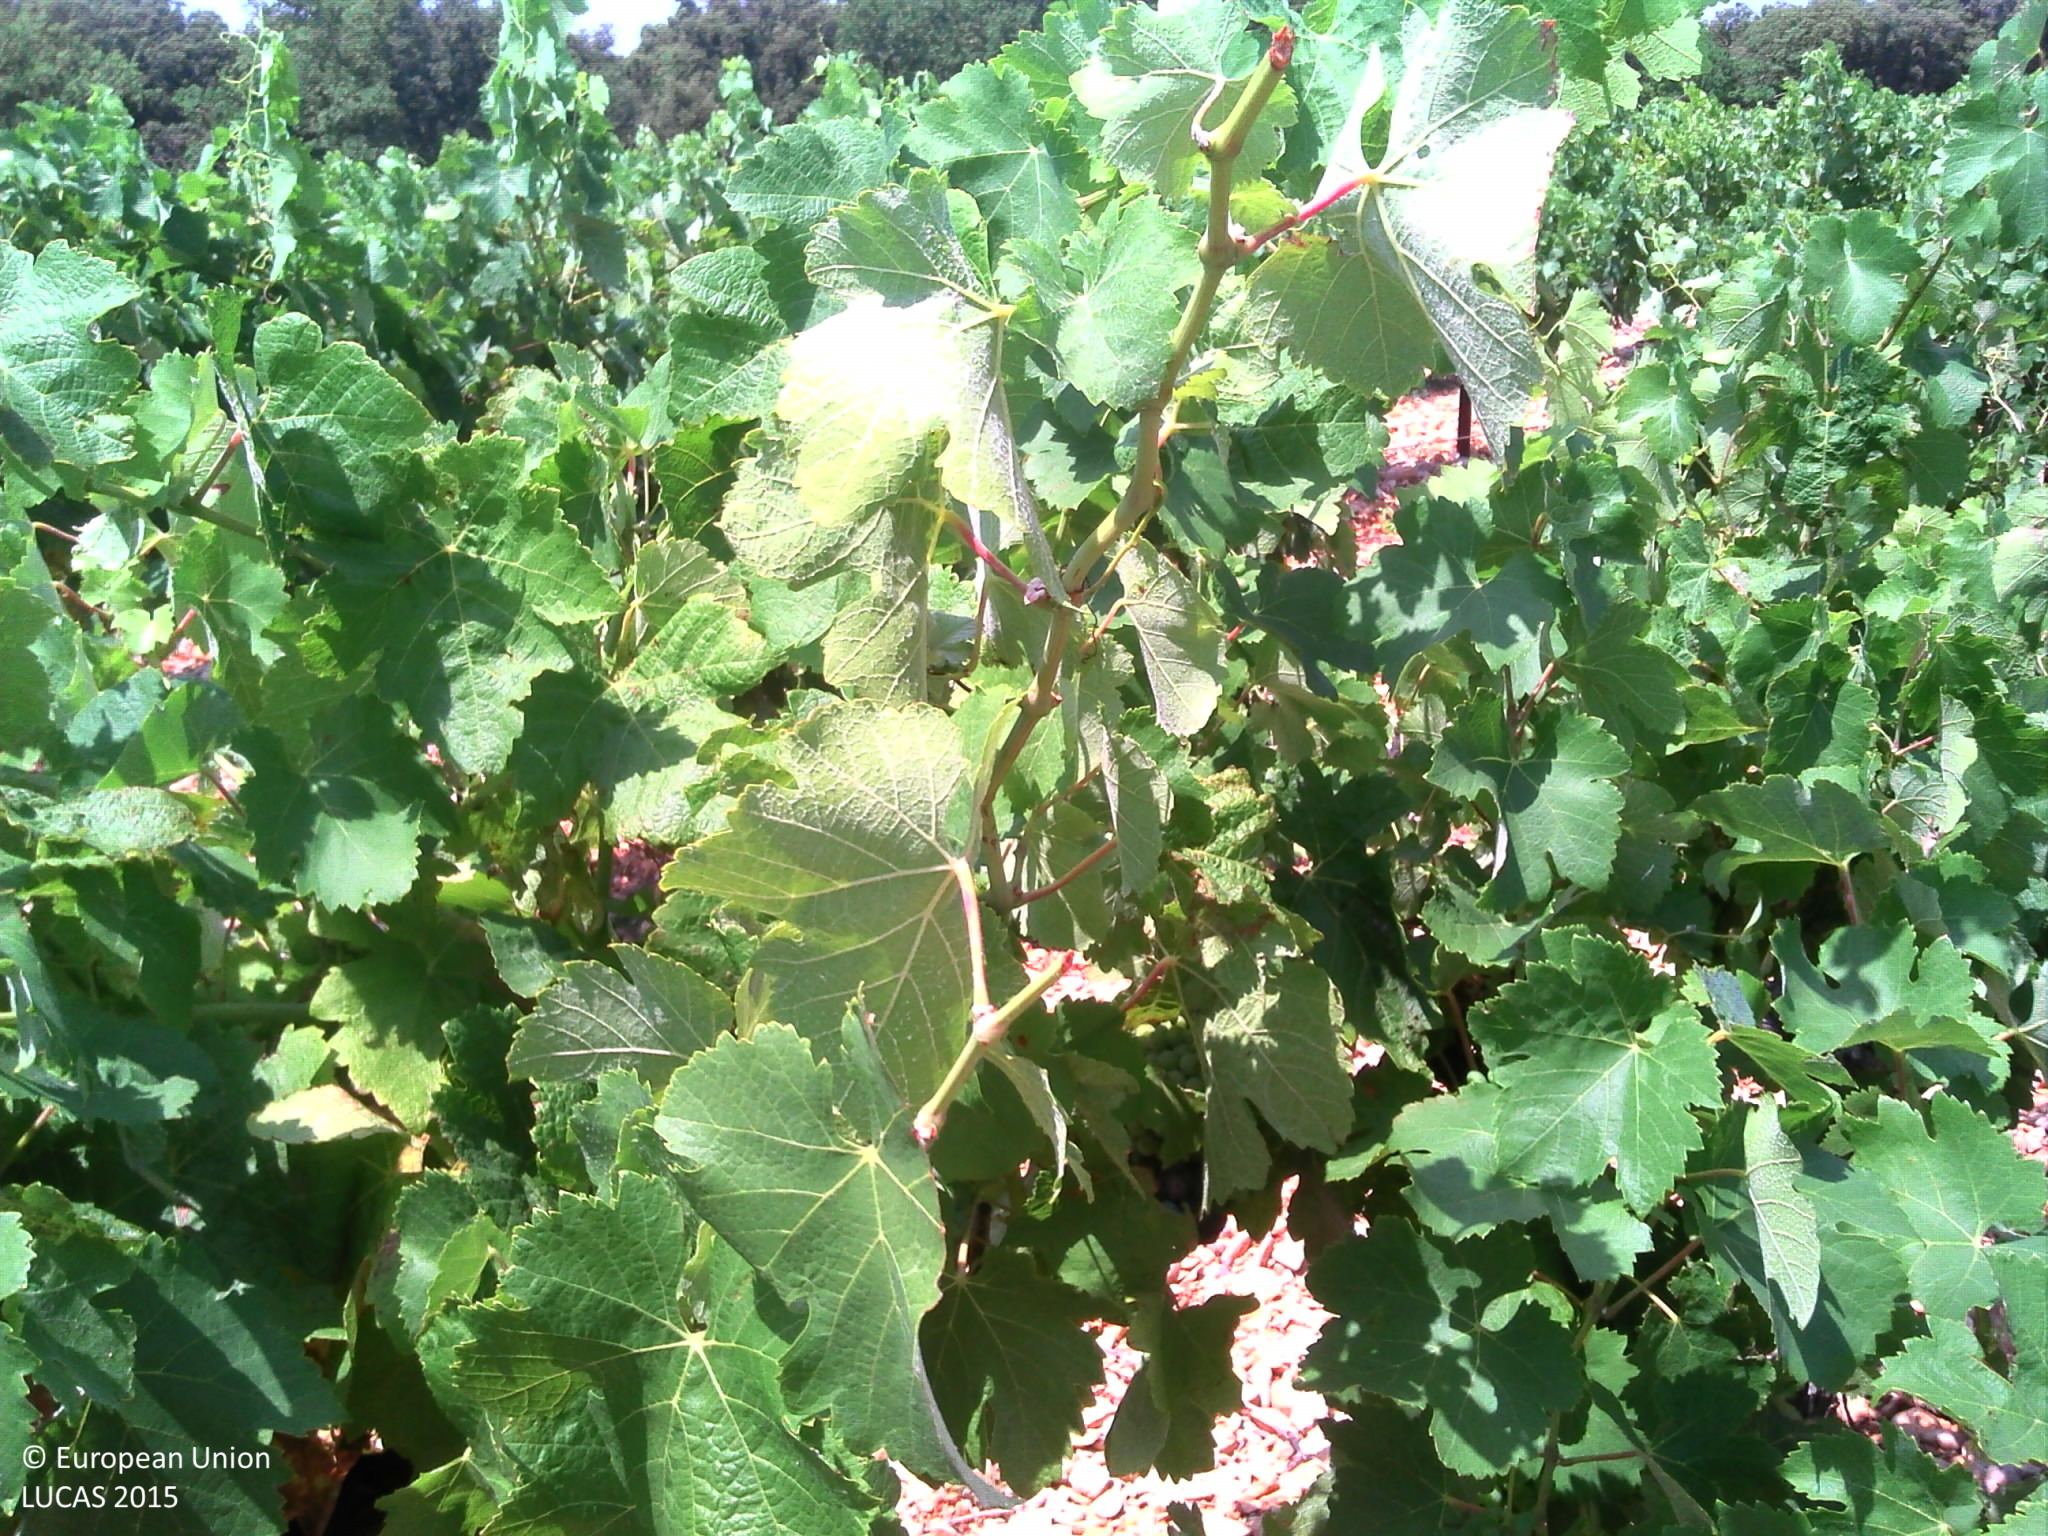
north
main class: Cropland
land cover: Vineyards
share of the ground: 25 - 50 %
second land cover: Other bare soil
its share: > 75 %
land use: Agriculture (excluding fallow land and kitchen gardens)
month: July
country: FR
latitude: 44.2761
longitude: 4.8330
